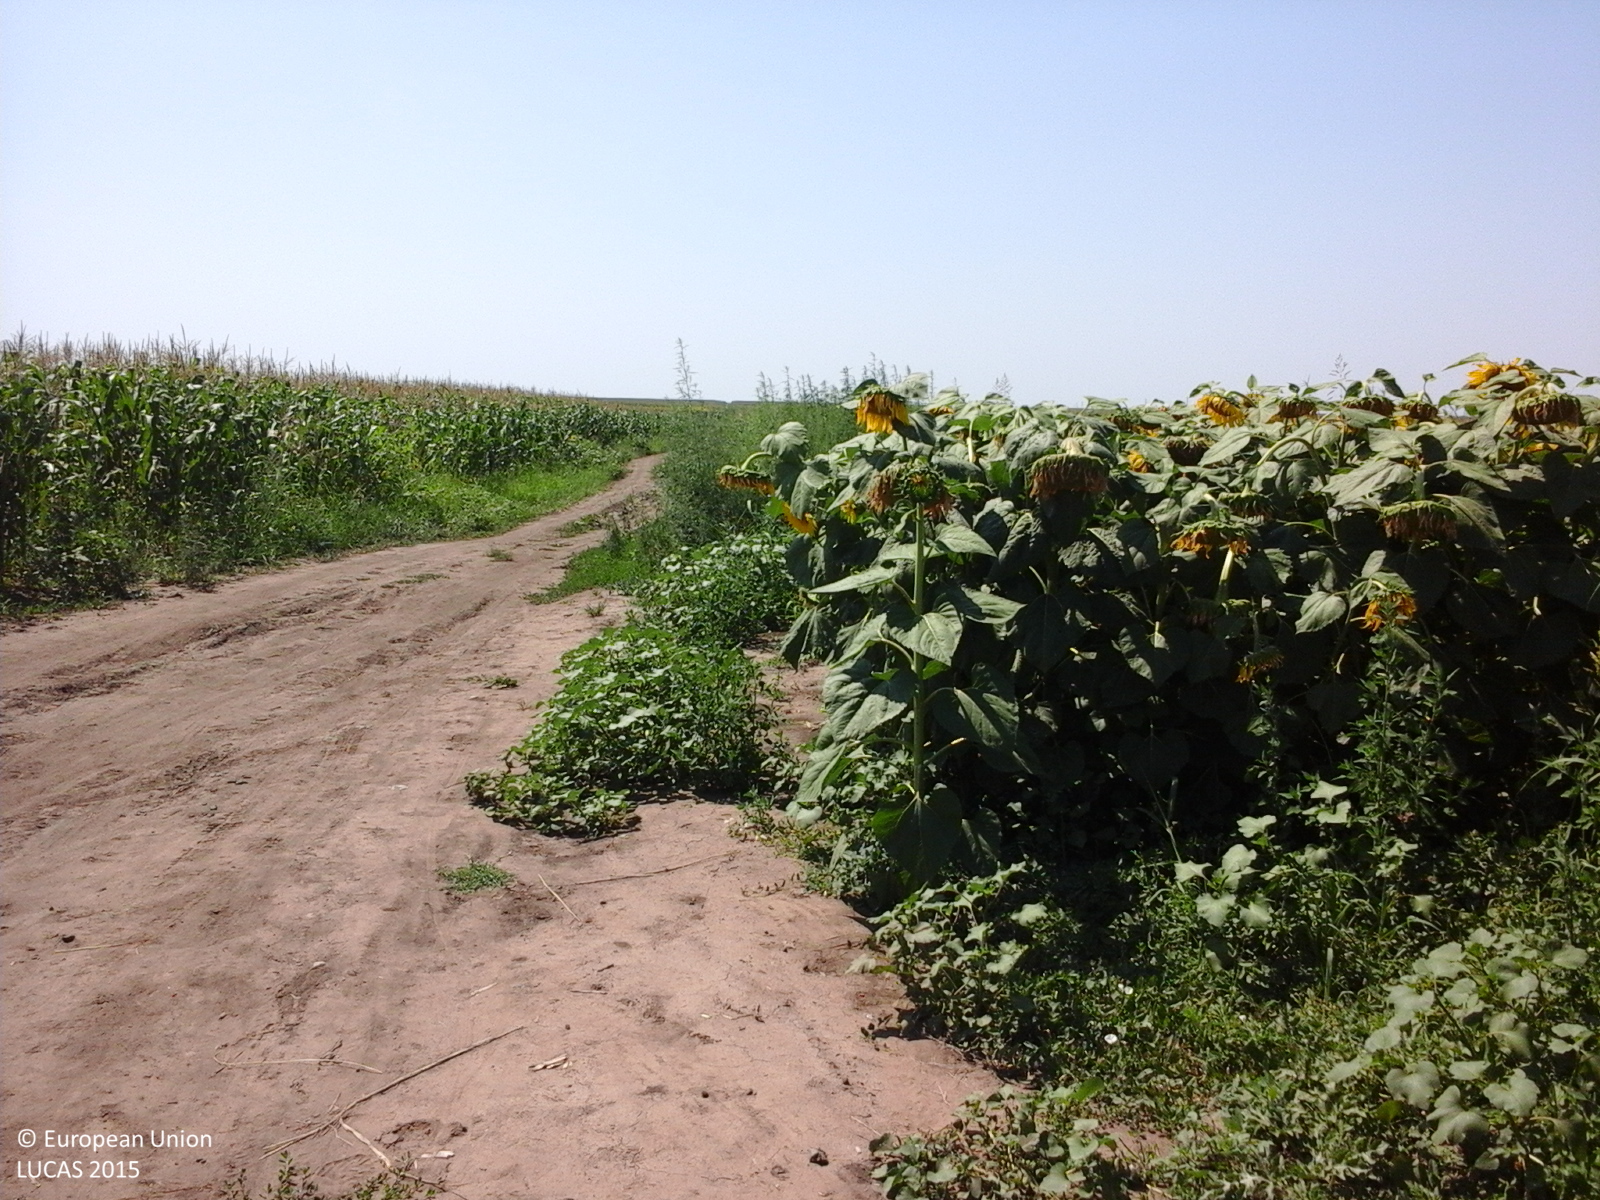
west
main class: Cropland
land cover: Sunflower
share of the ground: > 75 %
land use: Agriculture (excluding fallow land and kitchen gardens)
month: July
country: RO
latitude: 44.7843
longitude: 27.6029
